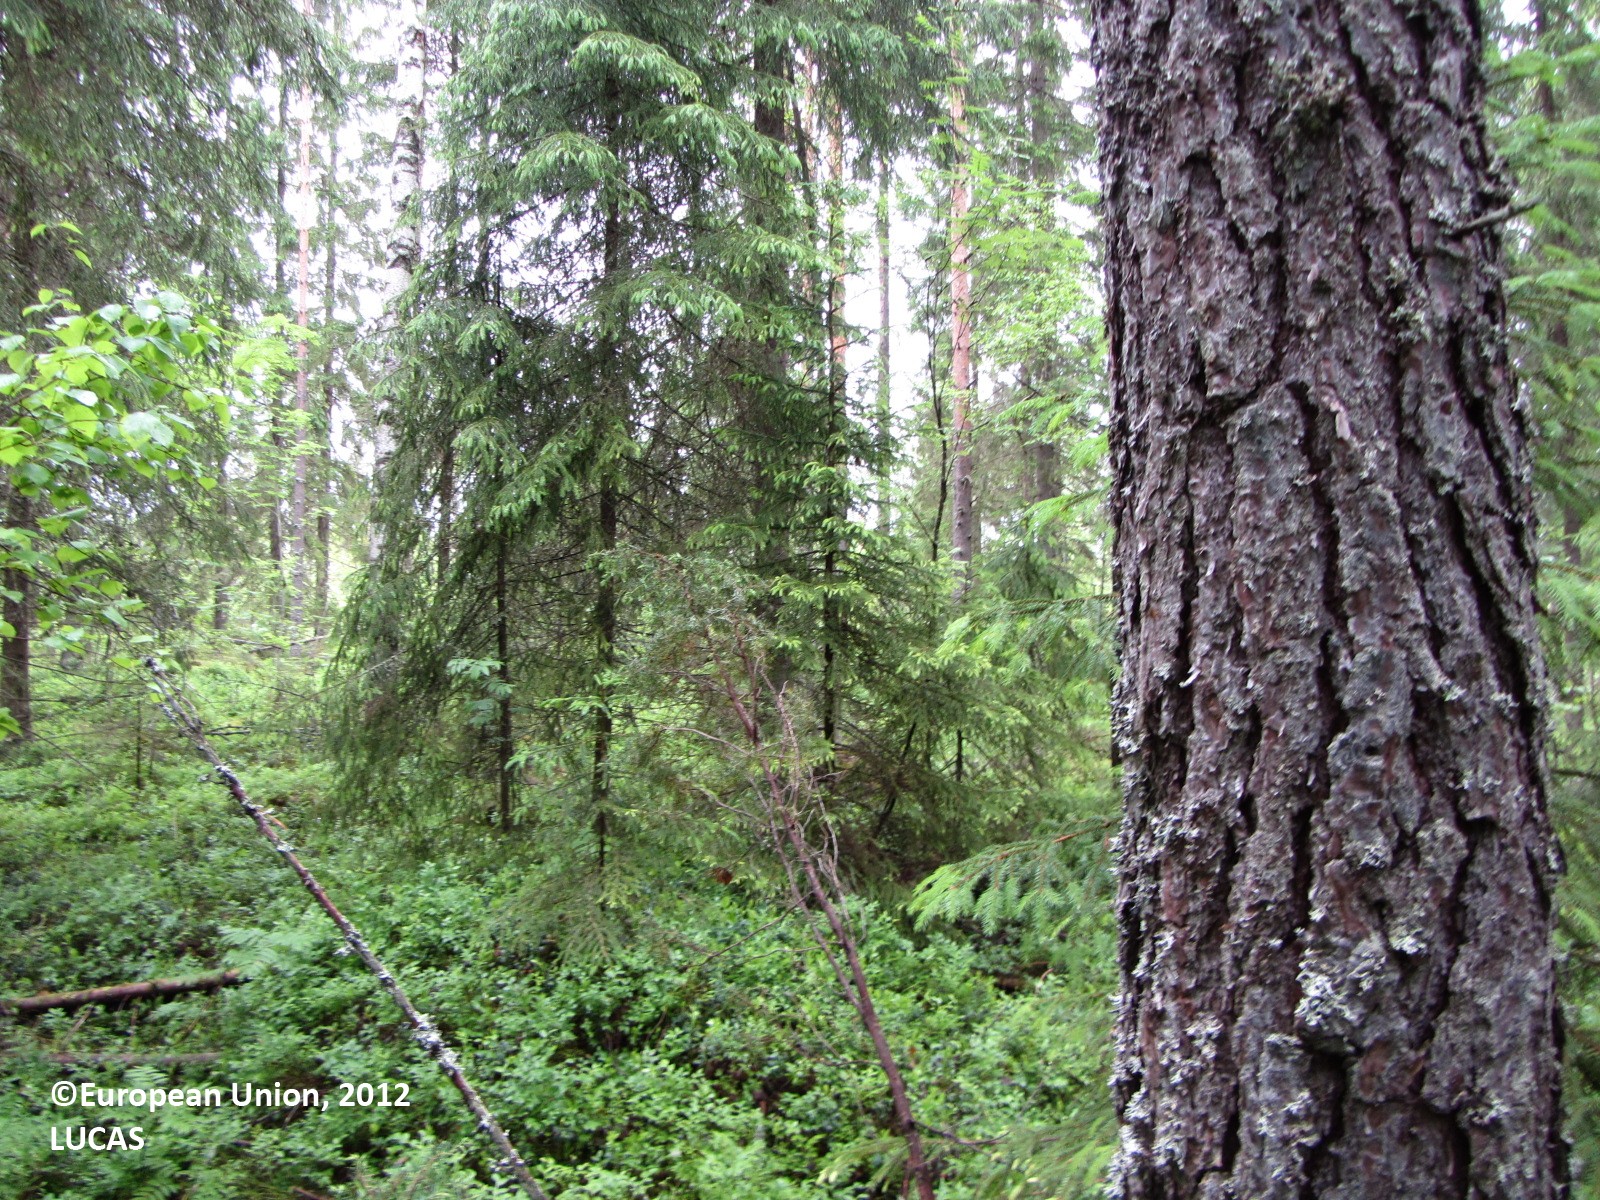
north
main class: Woodland
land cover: Other coniferous woodland
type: boreal forest
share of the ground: > 75 %
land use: Amenities, museums, leisure
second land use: Forestry
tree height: > 5 m
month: June
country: FI
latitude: 62.0160
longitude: 25.2209
